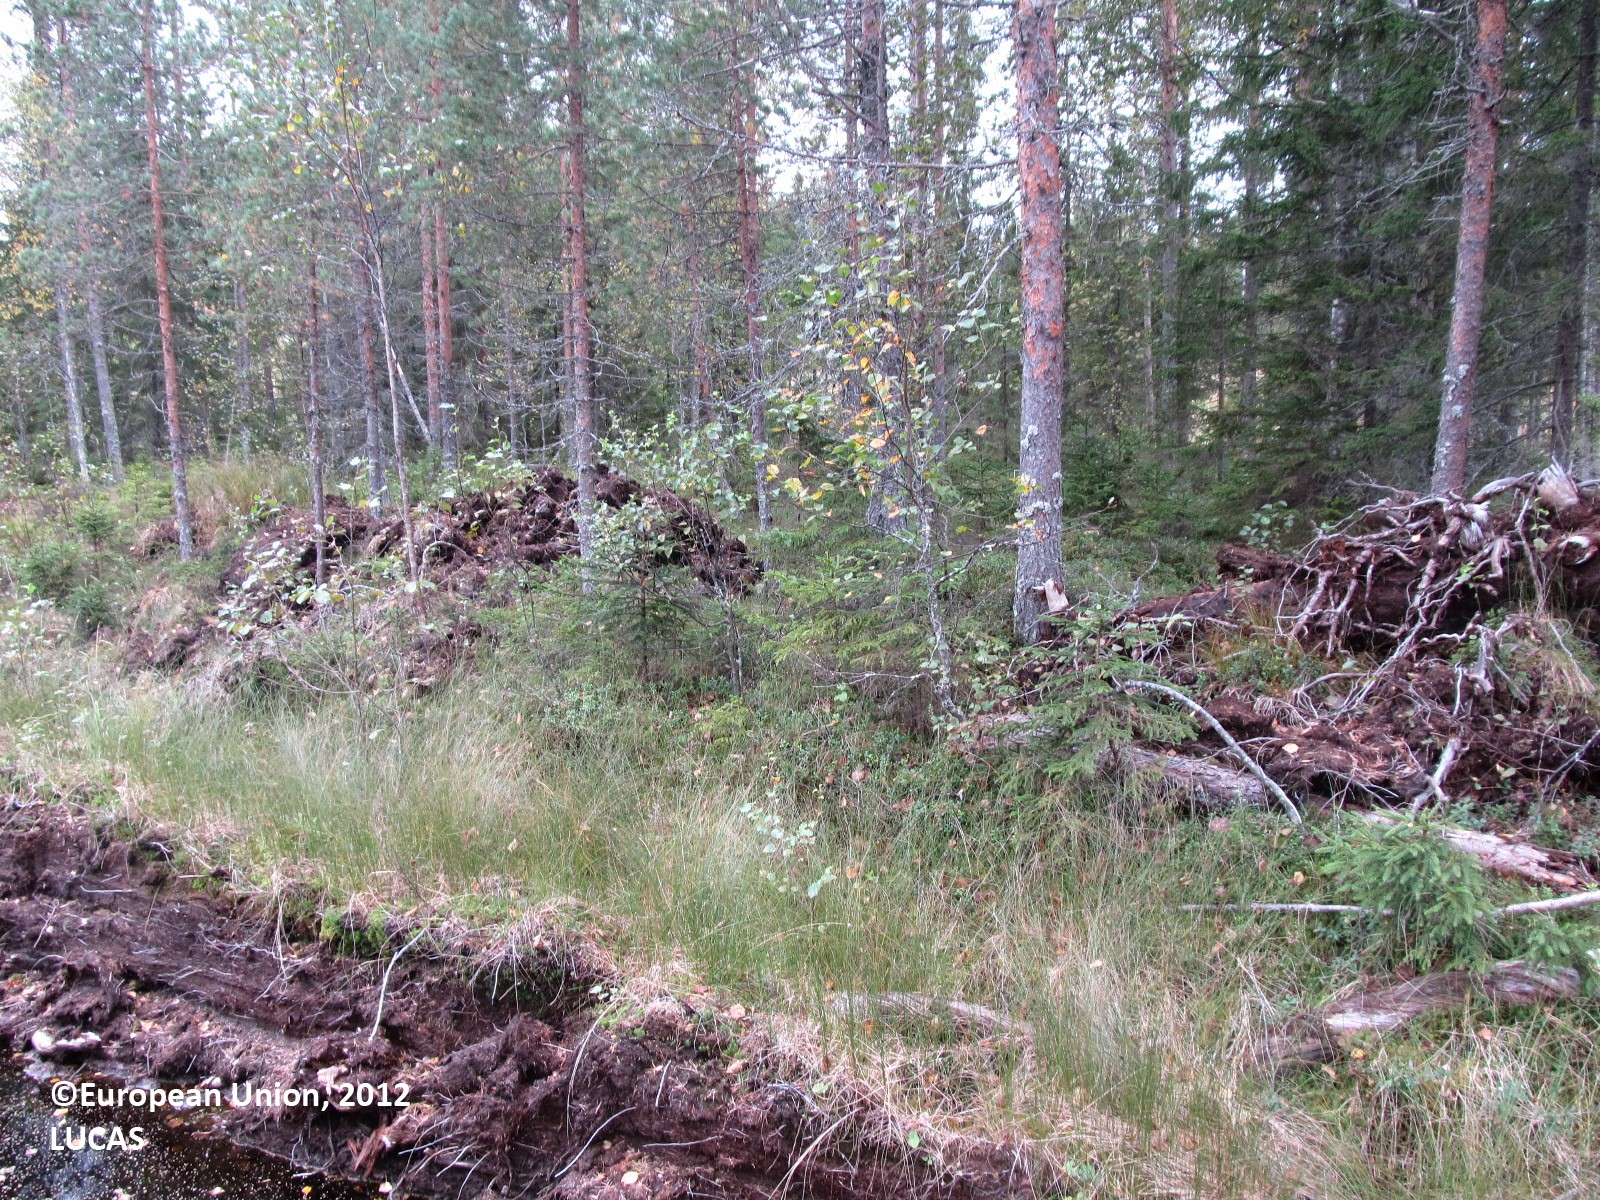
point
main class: Woodland
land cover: Pine dominated coniferous woodland
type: boreal forest
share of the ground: 25 - 50 %
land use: Forestry
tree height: > 5 m
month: September
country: FI
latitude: 63.0653
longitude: 28.5394
